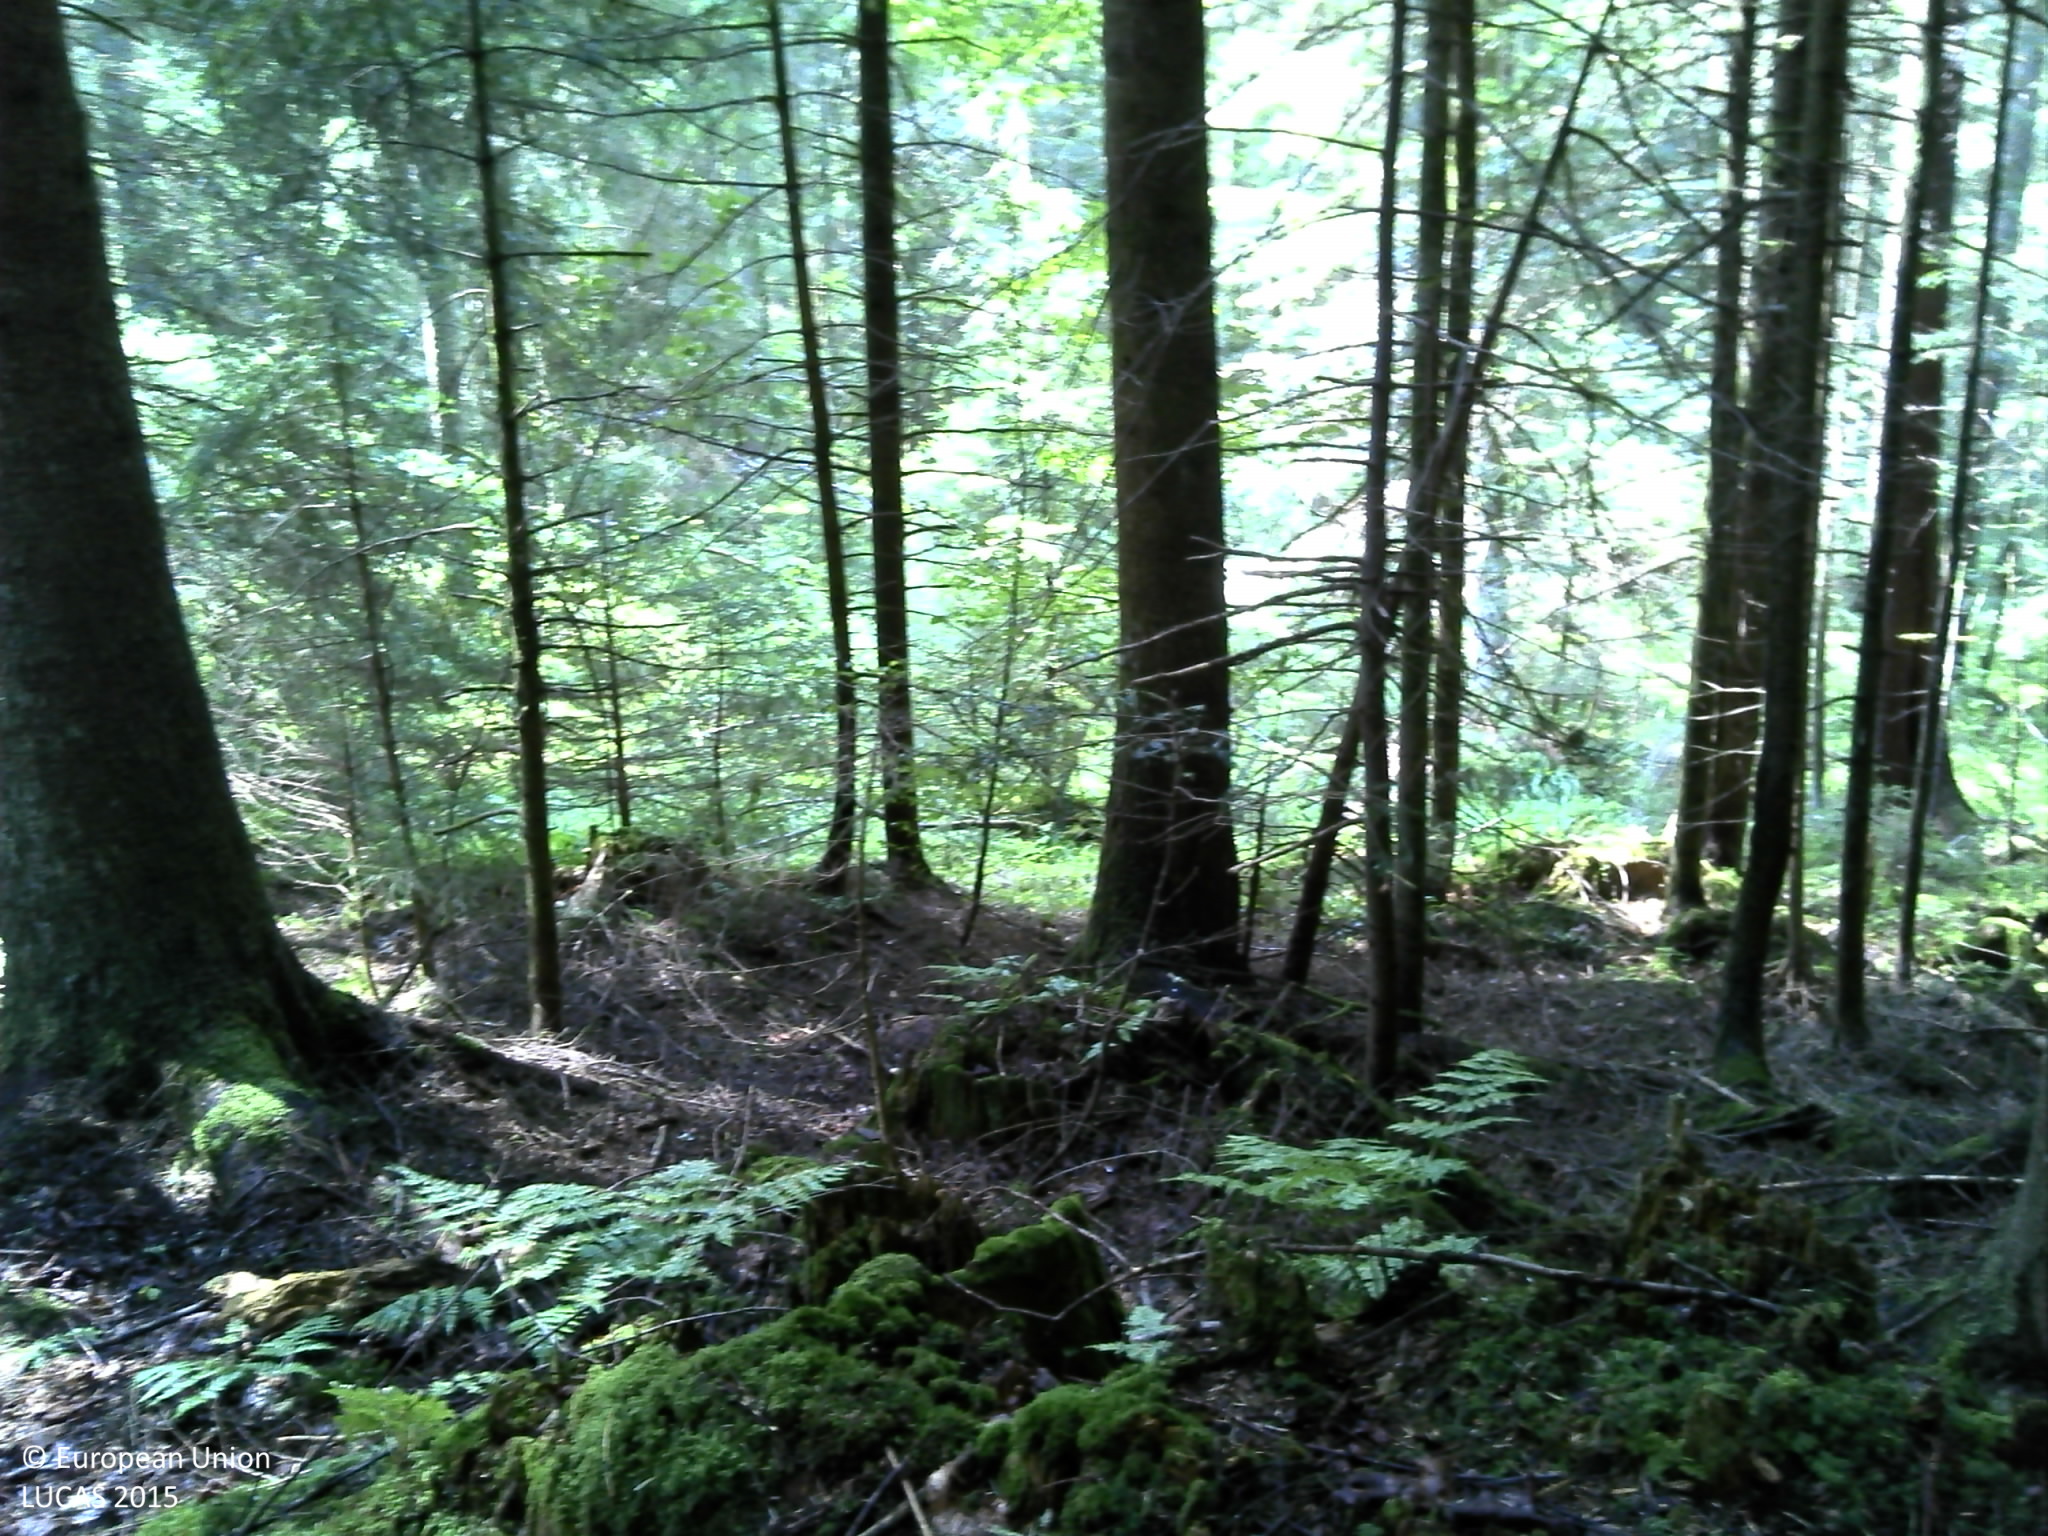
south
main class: Woodland
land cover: Spruce dominated coniferous woodland
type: exotic forest
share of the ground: > 75 %
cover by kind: coniferous forest trees 95 %, broadleaved forest trees 5 %
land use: Forestry
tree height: > 5 m
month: July
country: FR
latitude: 48.0876
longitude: 6.8192
